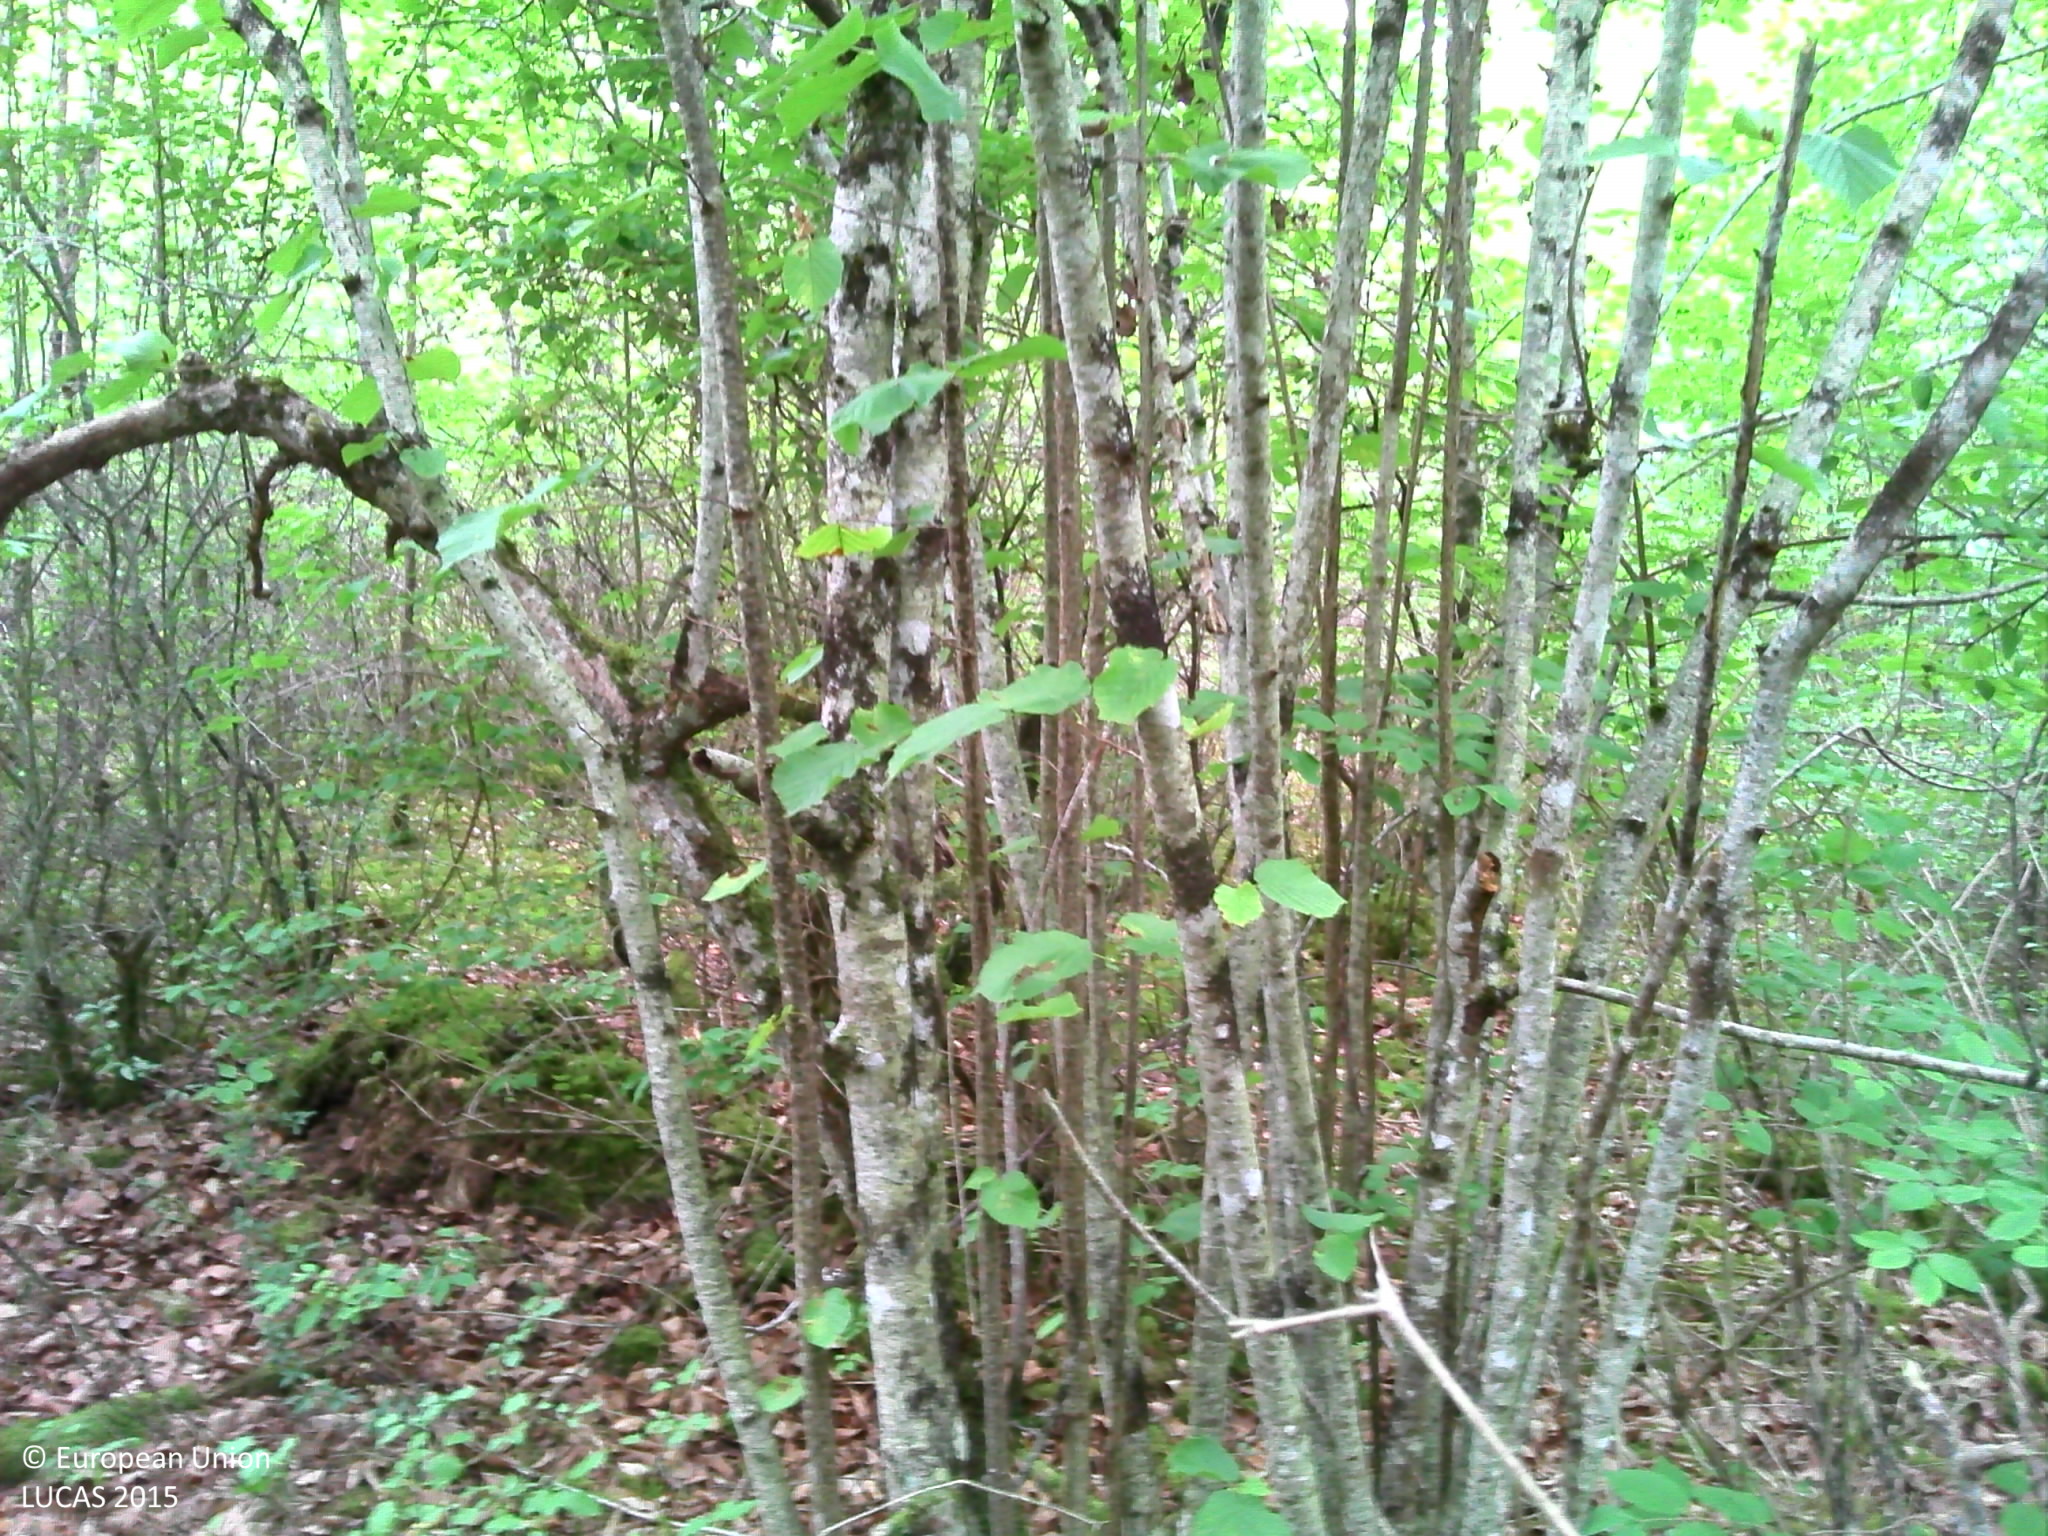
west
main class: Woodland
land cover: Pine dominated mixed woodland
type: acidophilous oak and oak-birch forest
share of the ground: > 75 %
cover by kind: broadleaved forest trees 60 %, coniferous forest trees 25 %, shrubs 5 %, herbaceous plants 5 %, lichens and mosses 5 %
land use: Forestry
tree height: > 5 m
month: August
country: FR
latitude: 47.9364
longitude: 4.3891
